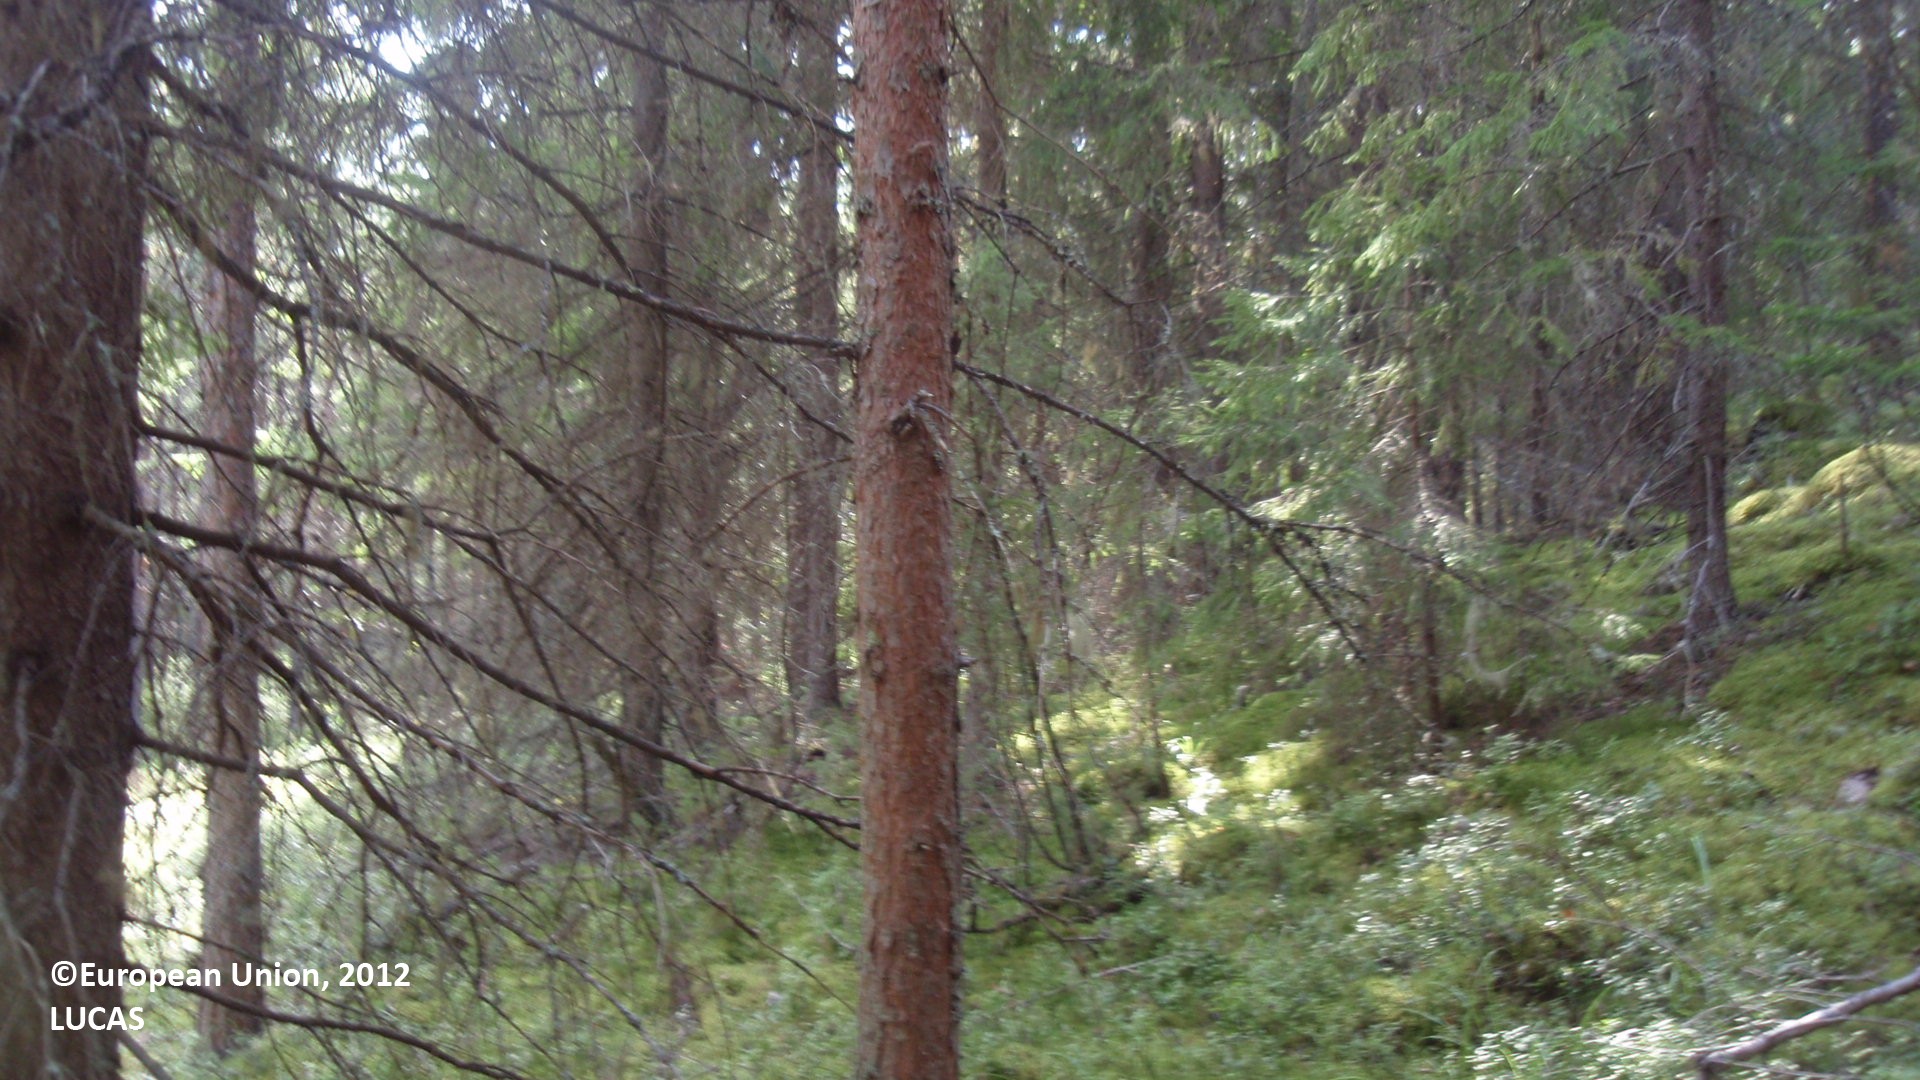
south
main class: Woodland
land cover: Spruce dominated coniferous woodland
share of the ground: 50 - 75 %
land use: Forestry
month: August
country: FI
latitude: 61.2027
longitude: 27.0449
